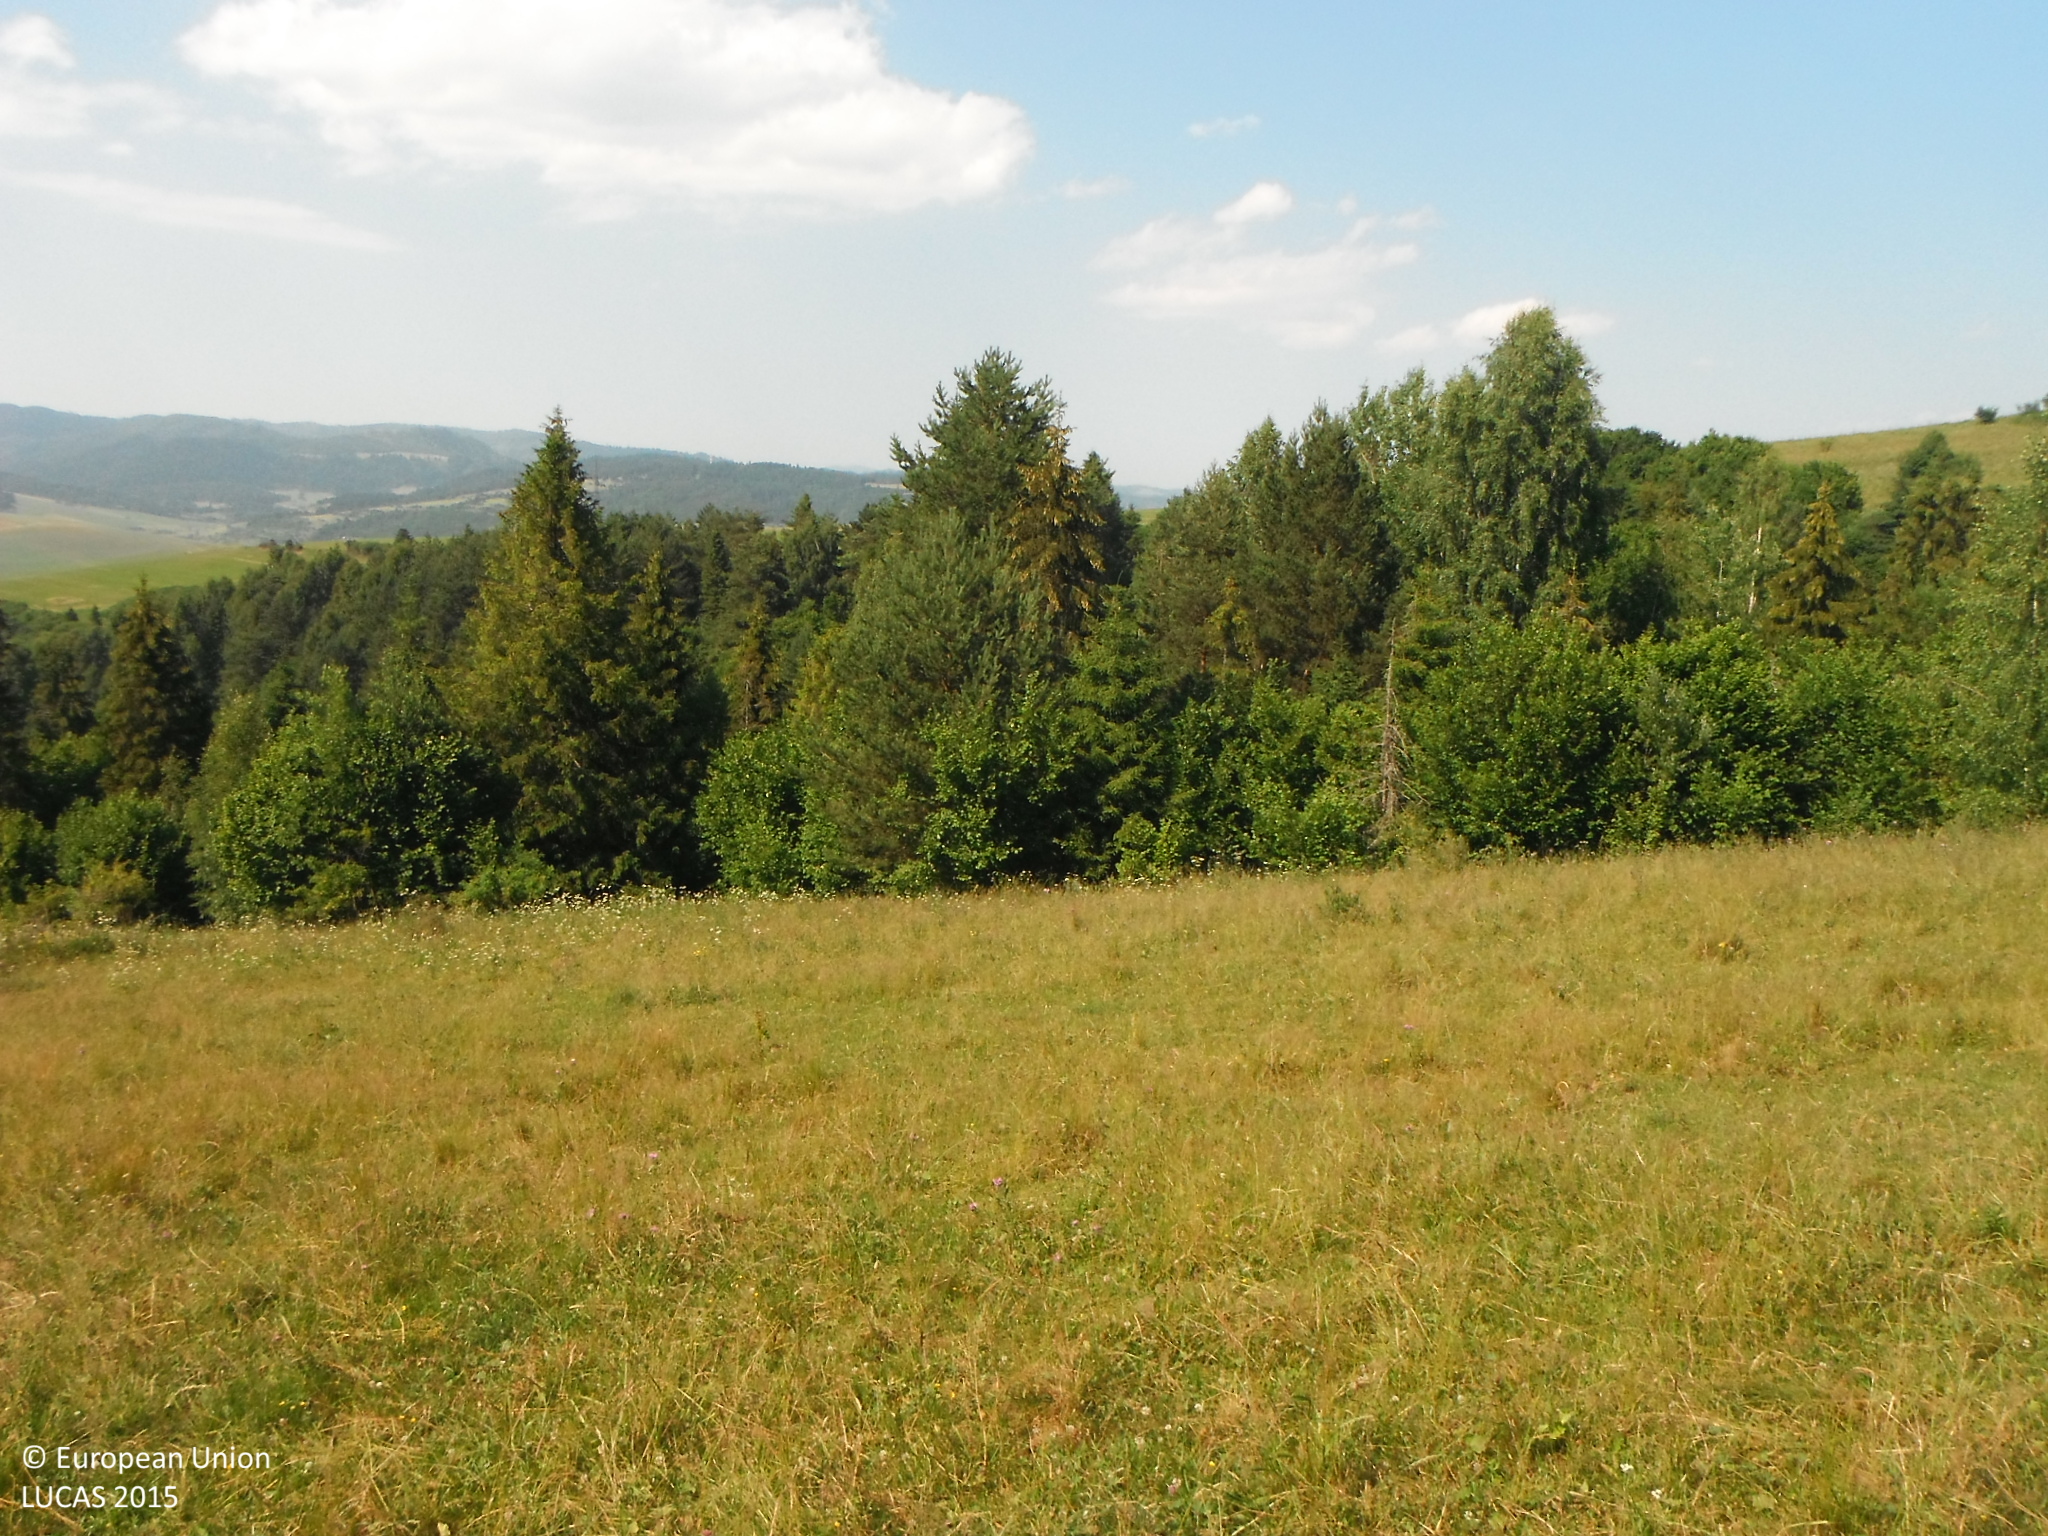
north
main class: Grassland
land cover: Grassland without tree/shrub cover
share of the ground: > 75 %
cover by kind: herbaceous plants 100 %
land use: Agriculture (excluding fallow land and kitchen gardens)
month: July
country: SK
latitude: 49.2404
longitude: 20.5445
